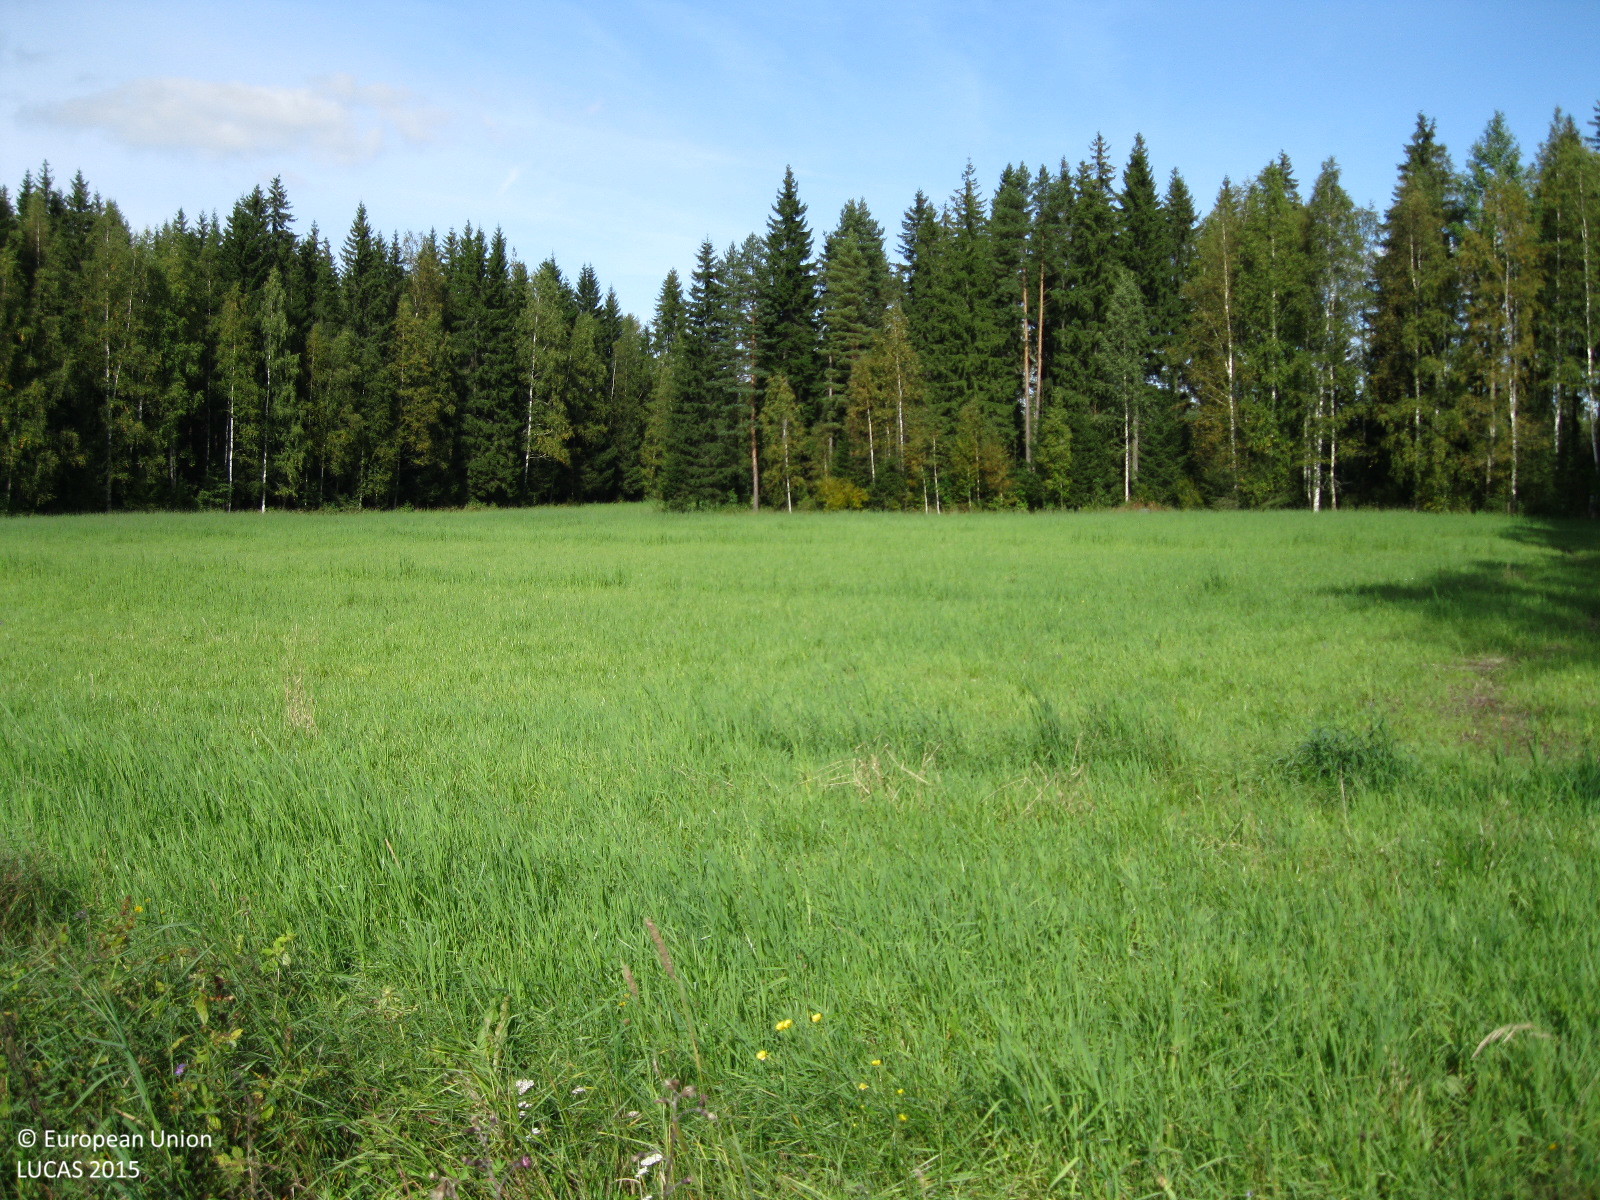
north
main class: Cropland
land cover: Oats
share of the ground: > 75 %
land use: Agriculture (excluding fallow land and kitchen gardens)
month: September
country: FI
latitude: 60.5499
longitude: 24.4548
